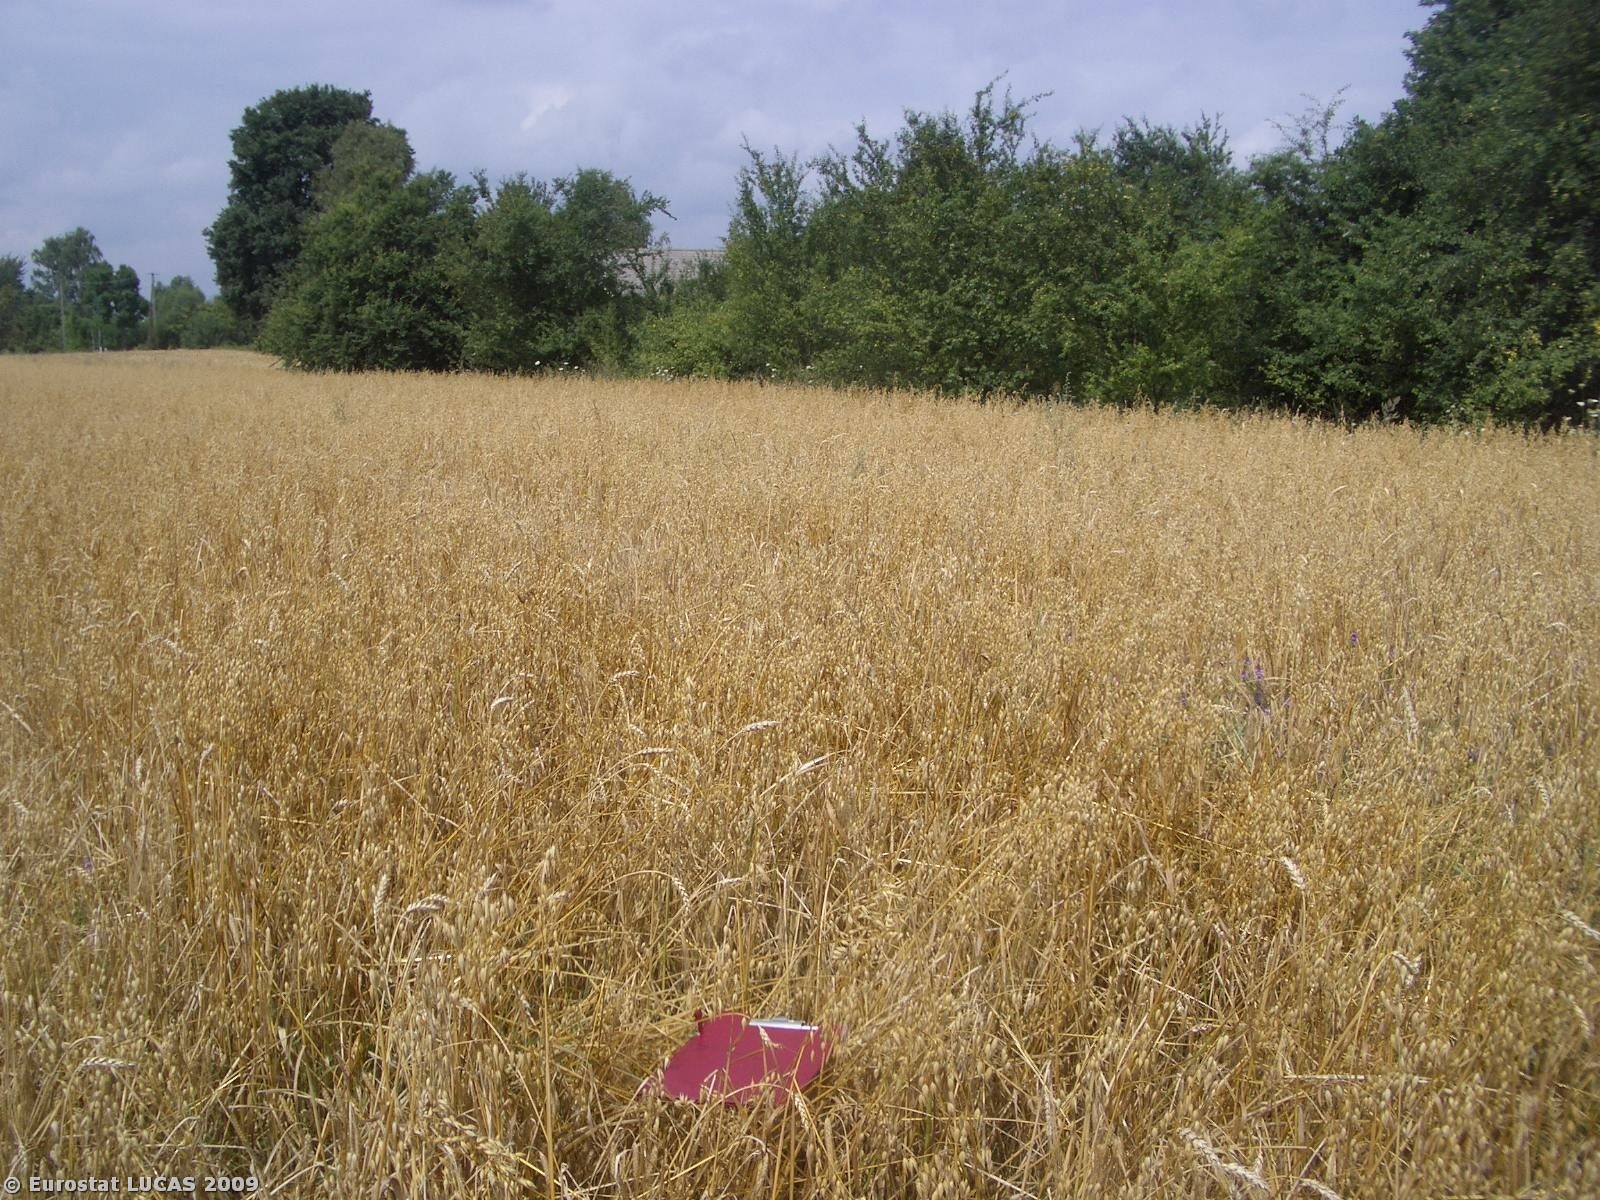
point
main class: Cropland
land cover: Oats
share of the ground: 50 - 75 %
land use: Agriculture (excluding fallow land and kitchen gardens)
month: August
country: PL
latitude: 51.7647
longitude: 23.1919
